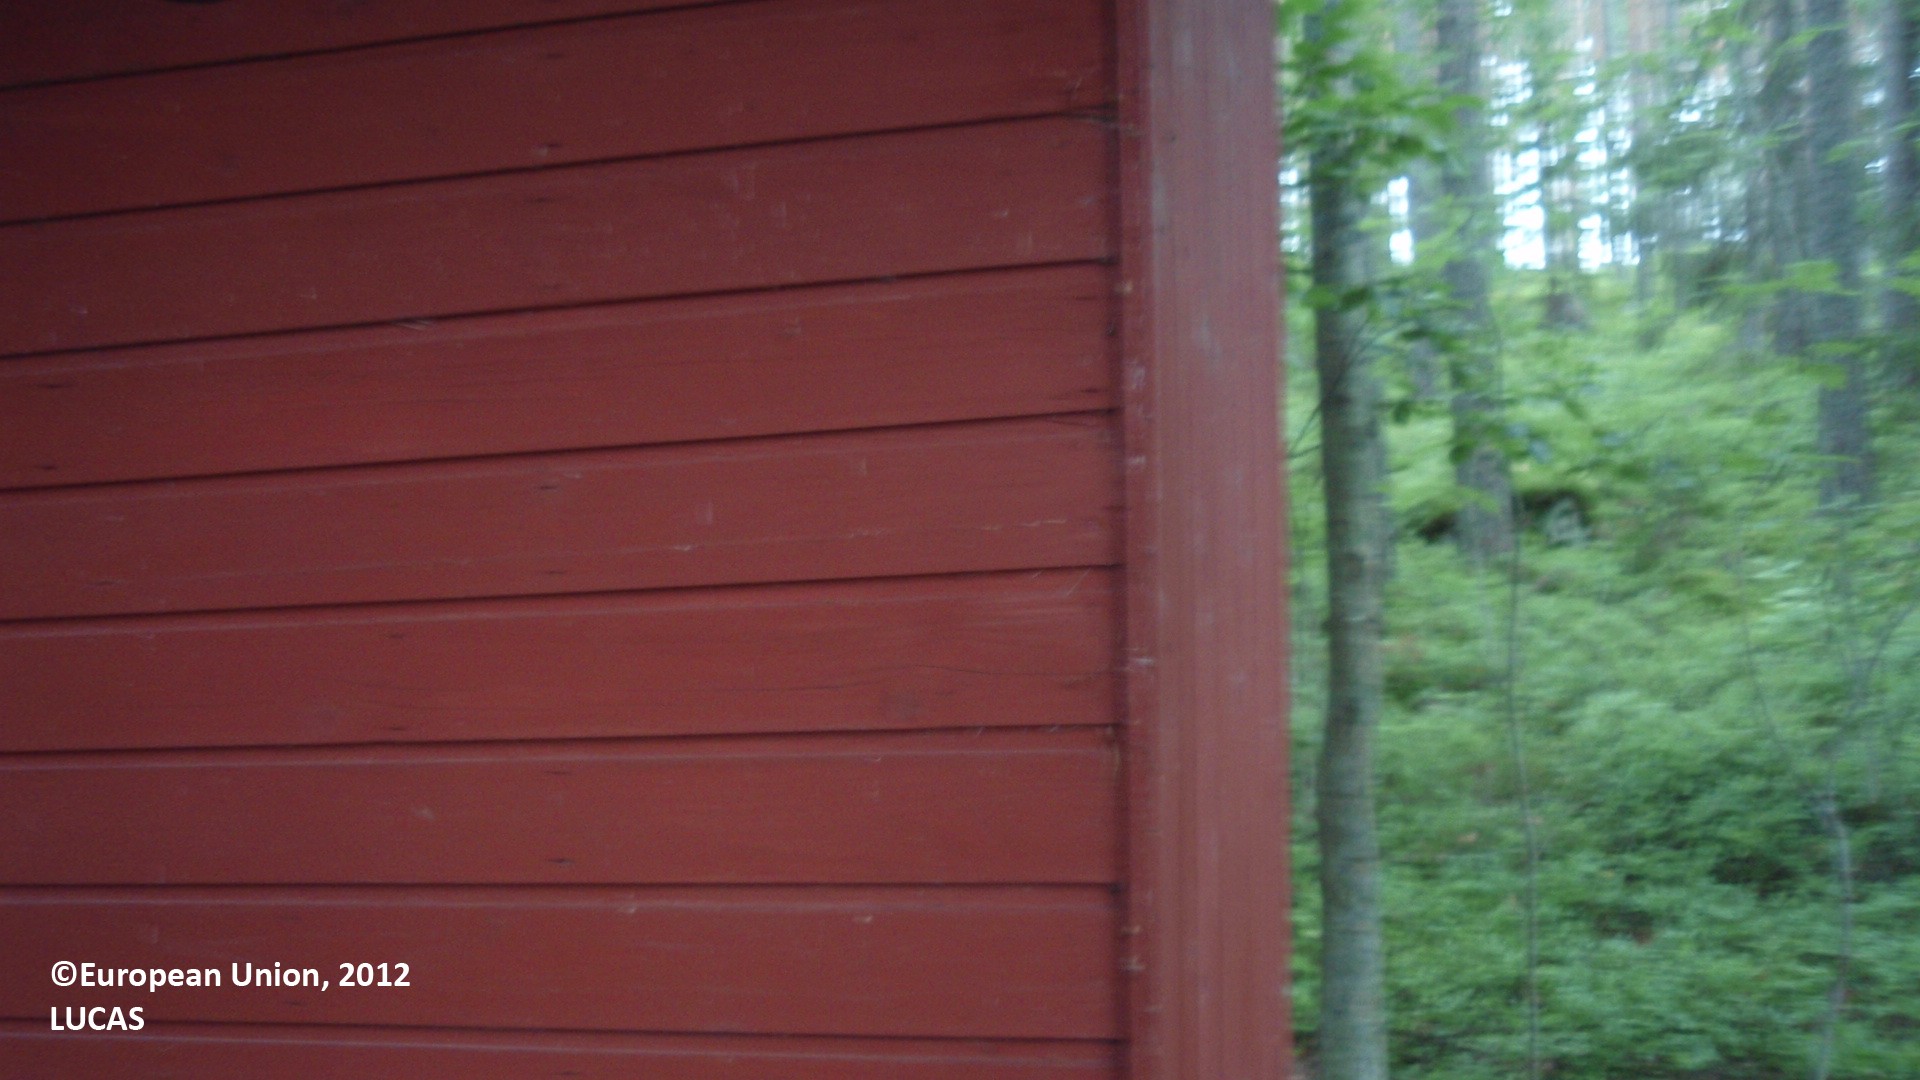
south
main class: Woodland
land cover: Other coniferous woodland
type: boreal forest
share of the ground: 50 - 75 %
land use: Forestry
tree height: > 5 m
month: August
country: FI
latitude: 60.9591
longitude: 26.9140
